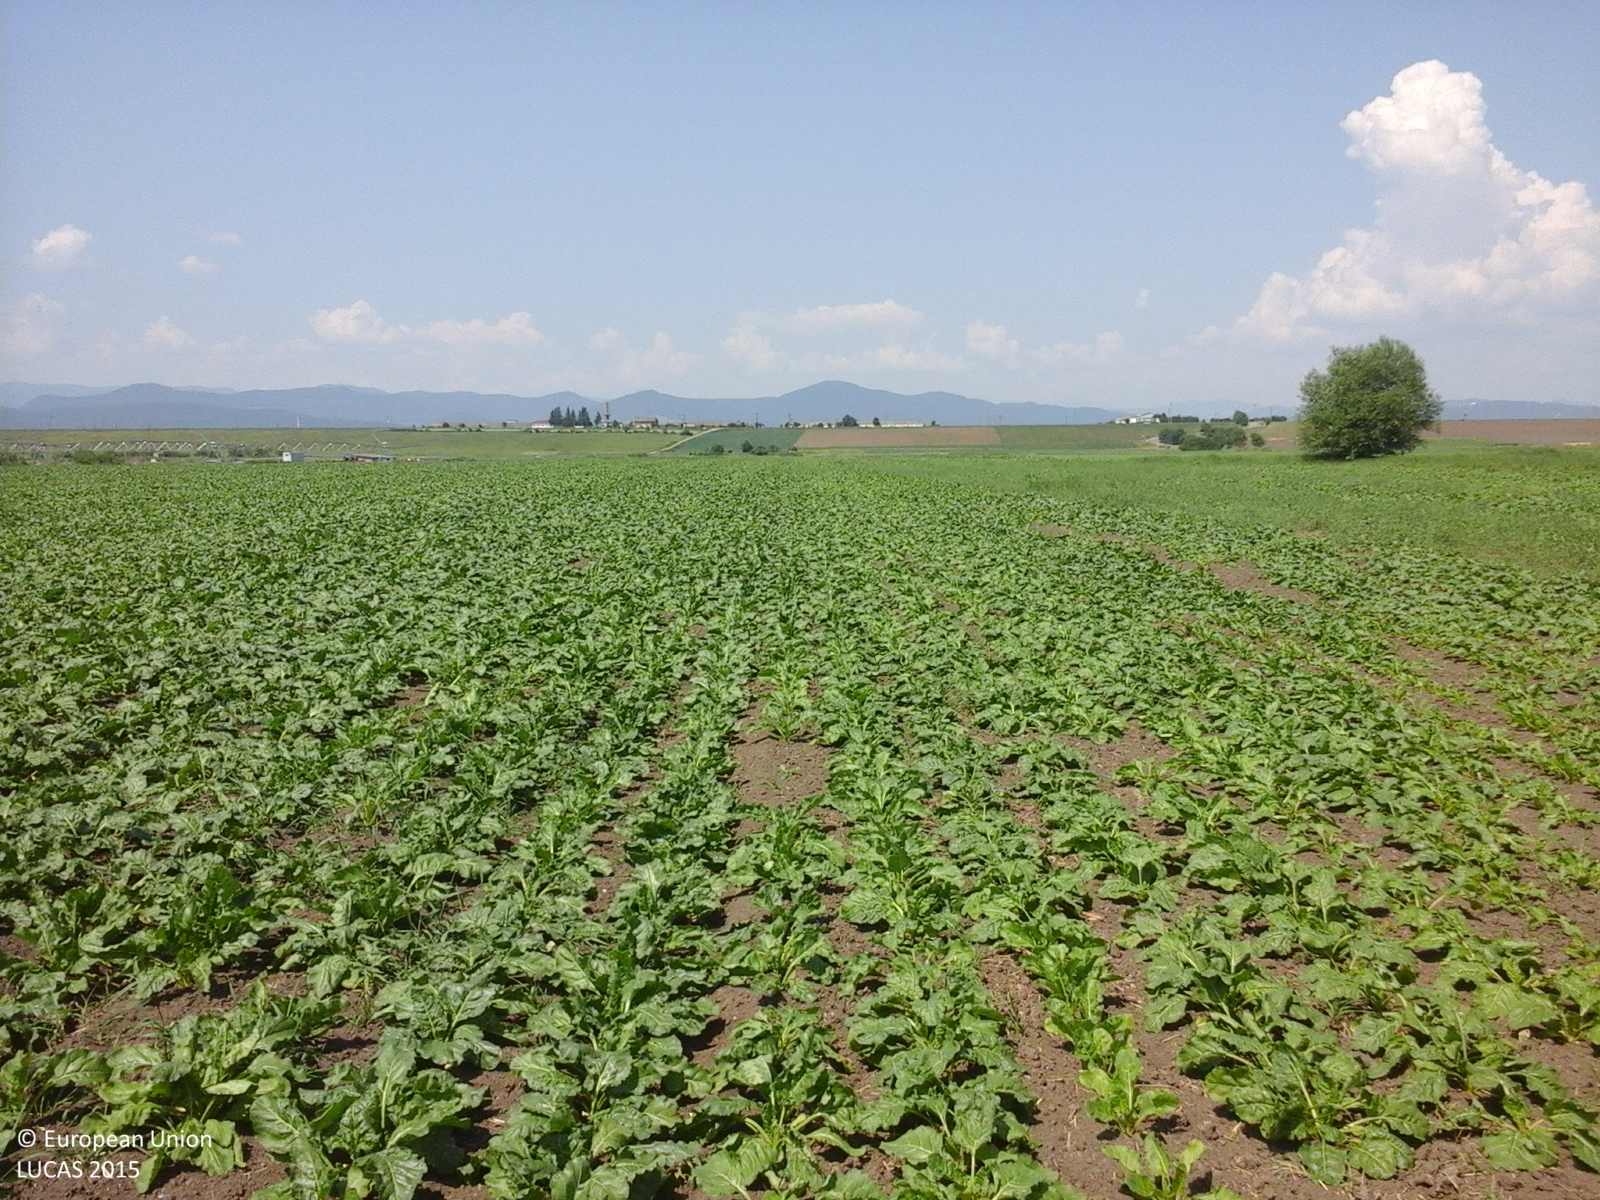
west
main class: Cropland
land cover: Other root crops
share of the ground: 50 - 75 %
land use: Agriculture (excluding fallow land and kitchen gardens)
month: June
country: RO
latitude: 46.8905
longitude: 26.5305
